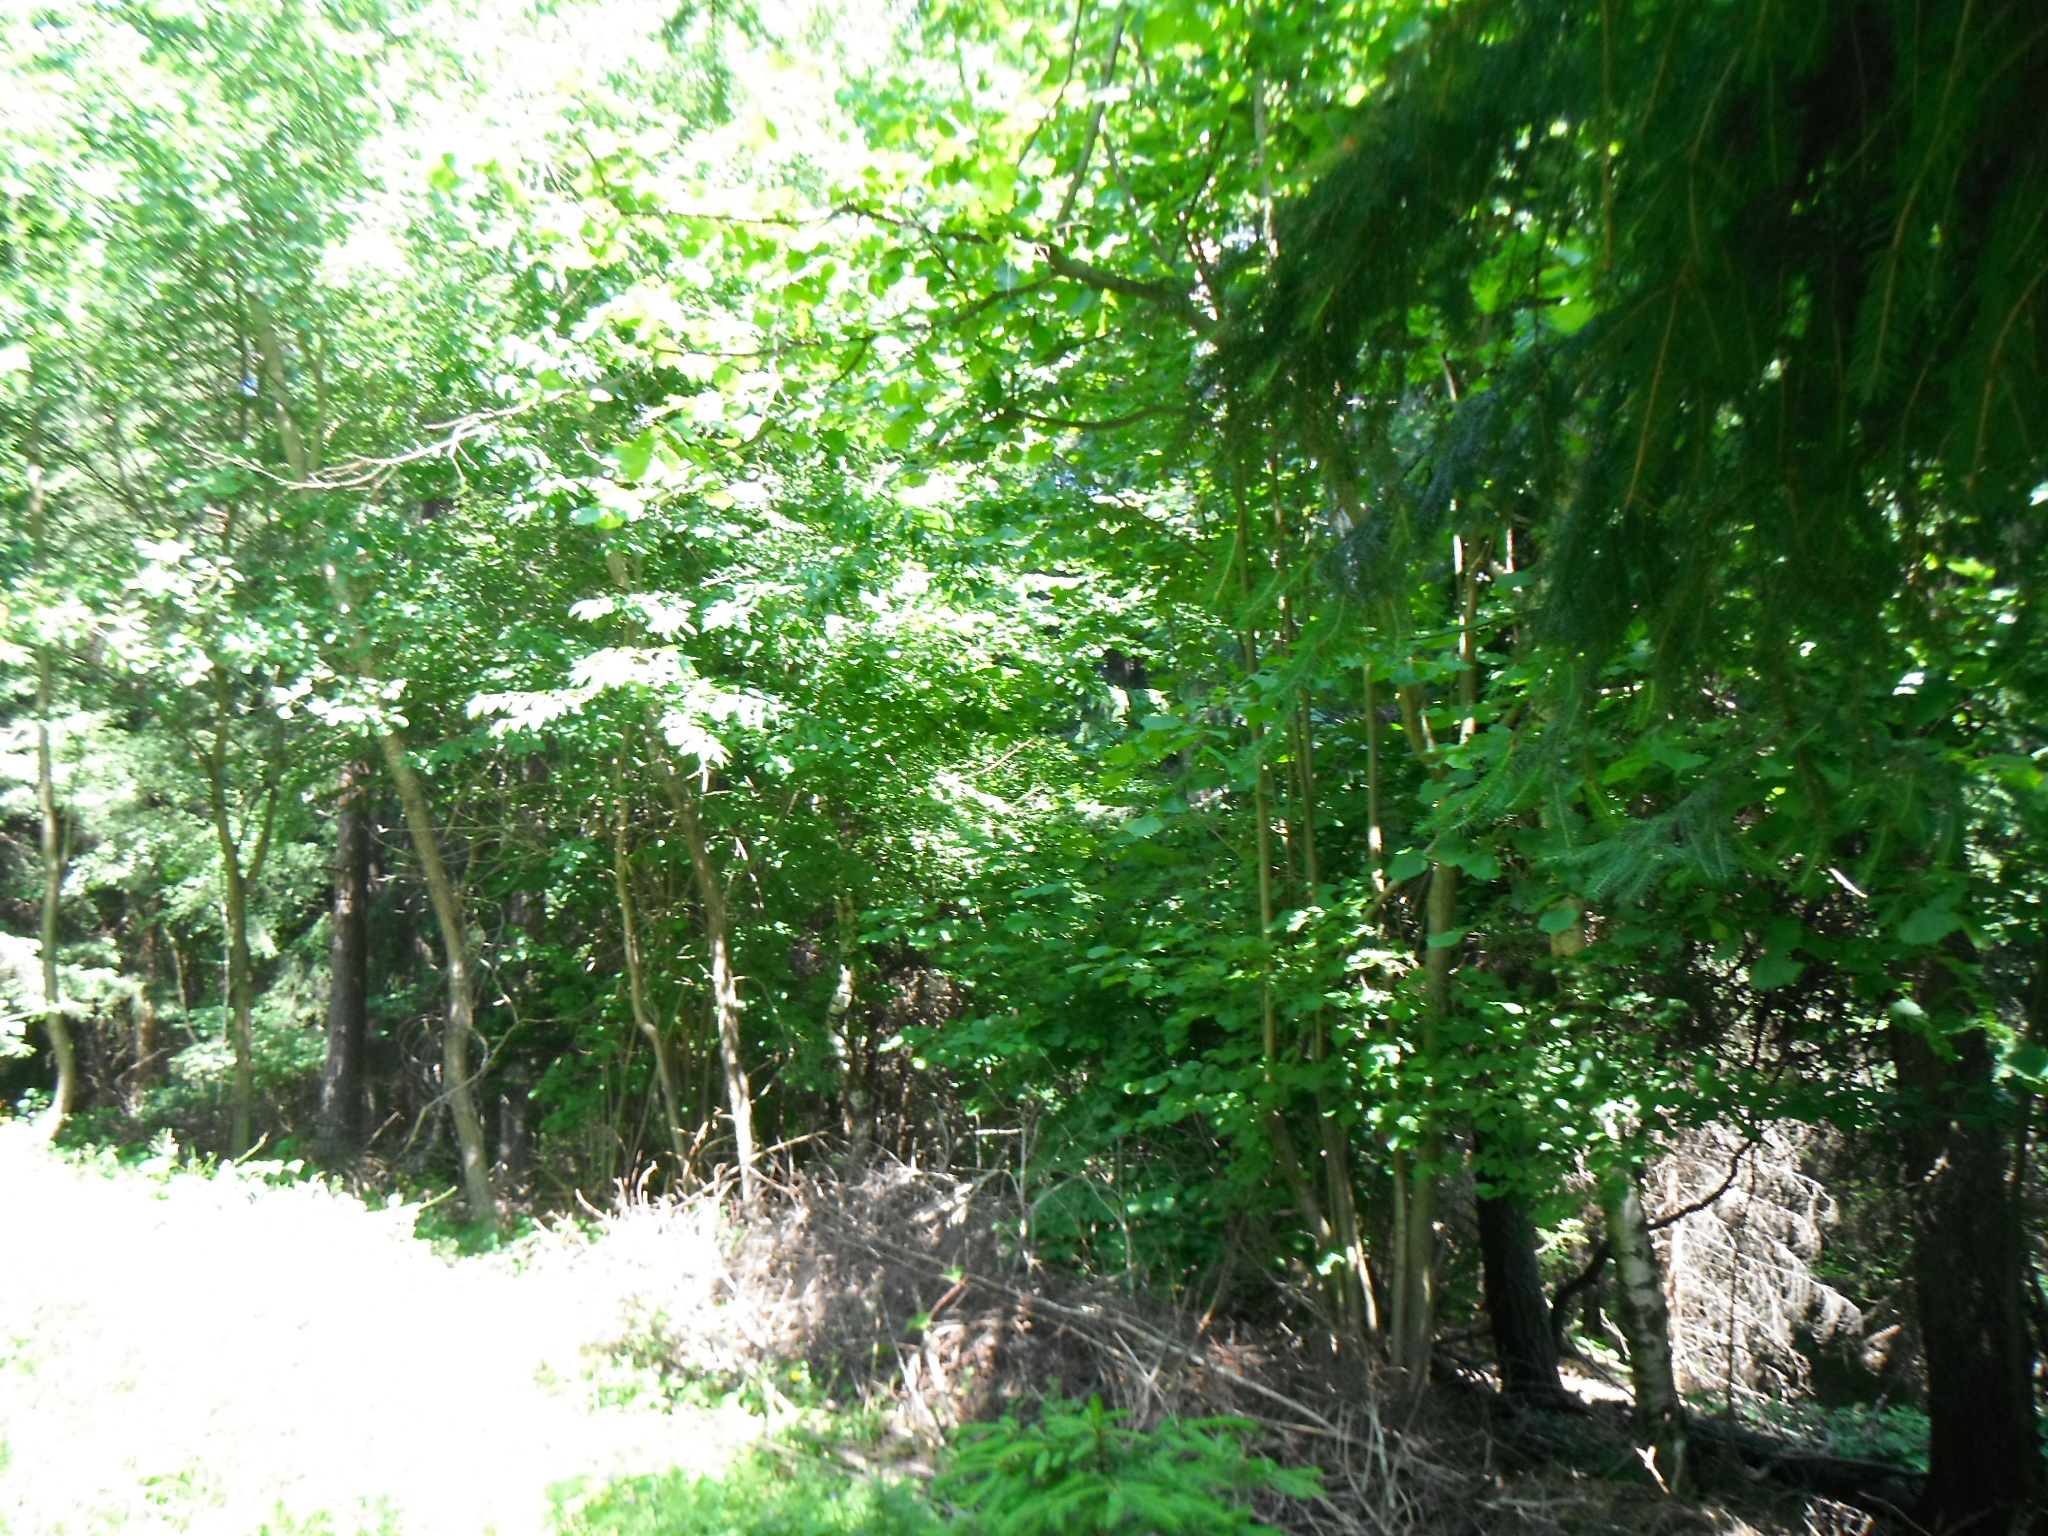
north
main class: Woodland
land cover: Spruce dominated mixed woodland
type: hemiboreal forest and nemoral coniferous forest and mixed broadleaved-coniferous forest
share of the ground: > 75 %
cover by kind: coniferous forest trees 50 %, broadleaved forest trees 25 %, herbaceous plants 15 %, shrubs 10 %
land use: Forestry
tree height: > 5 m
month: July
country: SK
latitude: 49.2698
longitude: 18.4978
